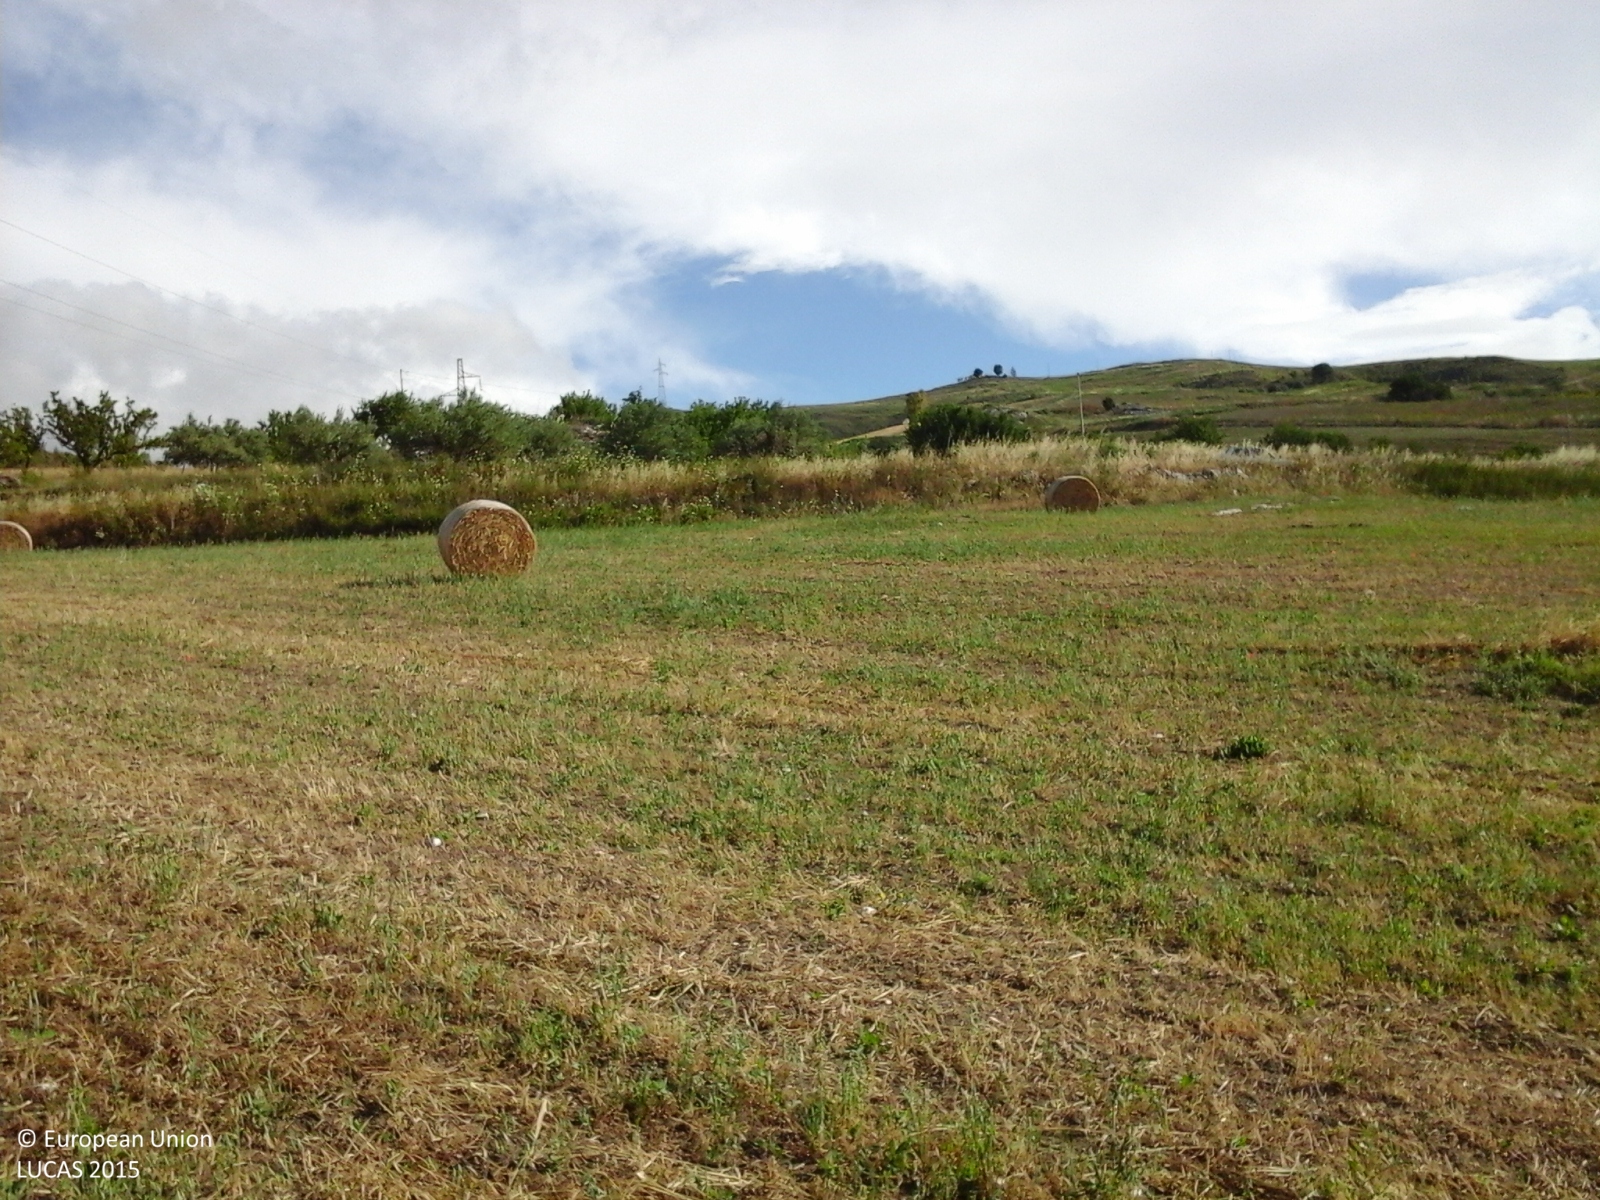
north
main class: Cropland
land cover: Durum wheat
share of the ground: > 75 %
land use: Agriculture (excluding fallow land and kitchen gardens)
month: June
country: IT
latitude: 37.5720
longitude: 14.0124
